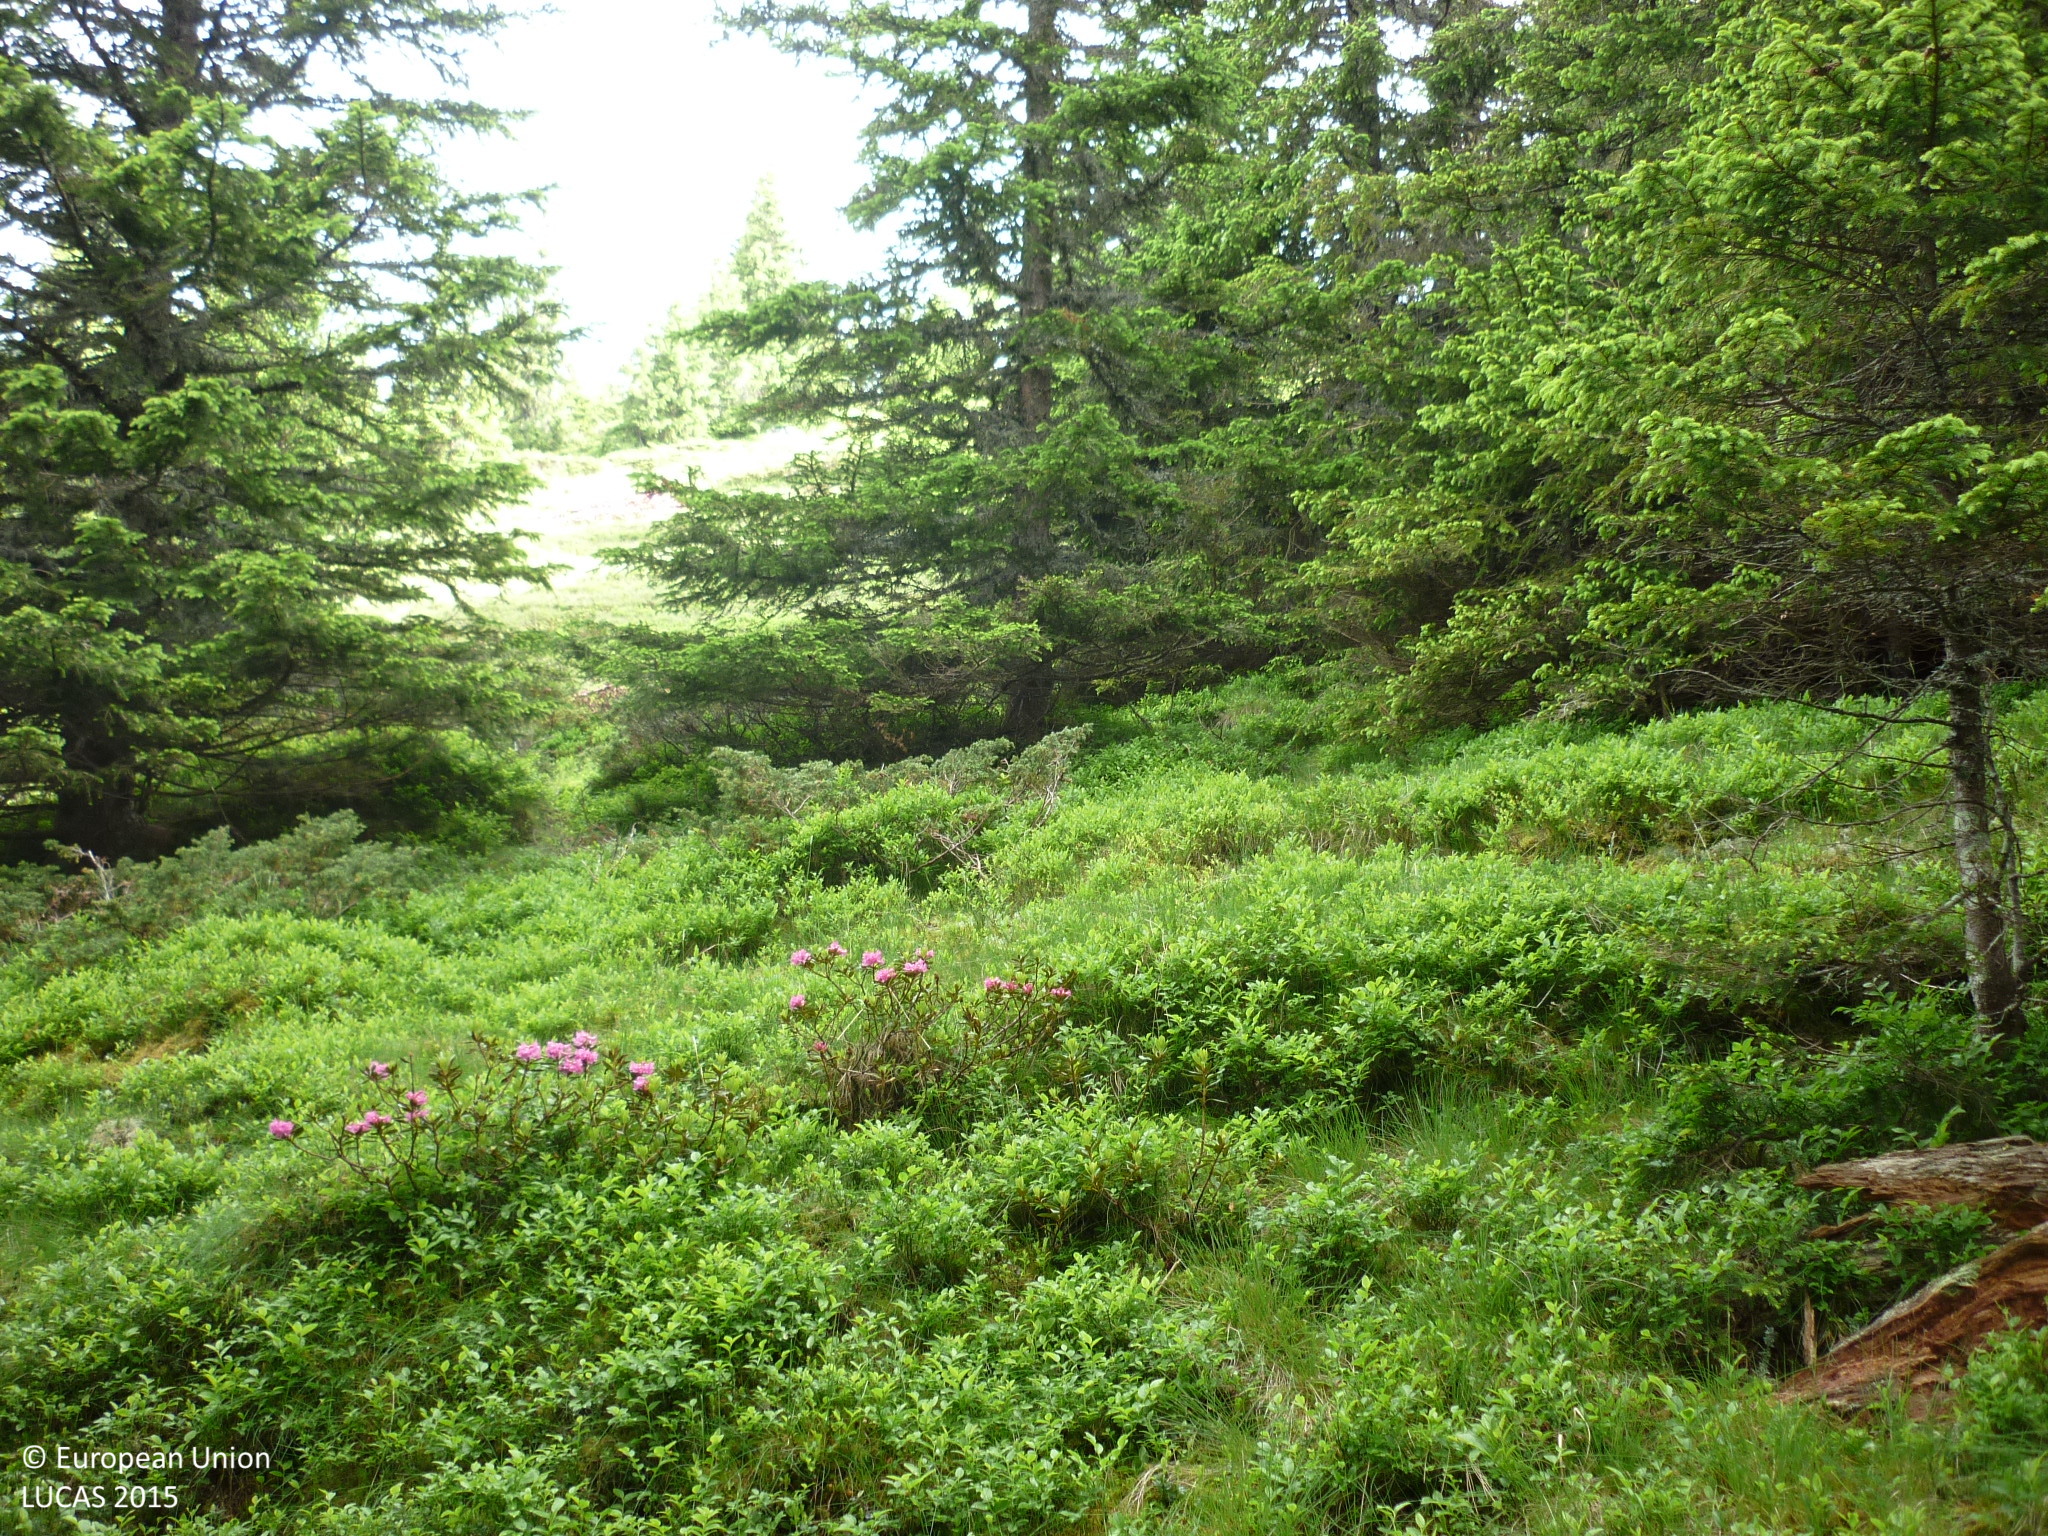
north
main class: Woodland
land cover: Spruce dominated coniferous woodland
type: alpine coniferous forest
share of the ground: 50 - 75 %
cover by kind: coniferous forest trees 60 %, herbaceous plants 20 %, shrubs 15 %, lichens and mosses 5 %
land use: Agriculture (excluding fallow land and kitchen gardens)
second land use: Forestry
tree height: > 5 m
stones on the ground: < 10 %
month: June
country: AT
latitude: 47.2260
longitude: 14.1585
